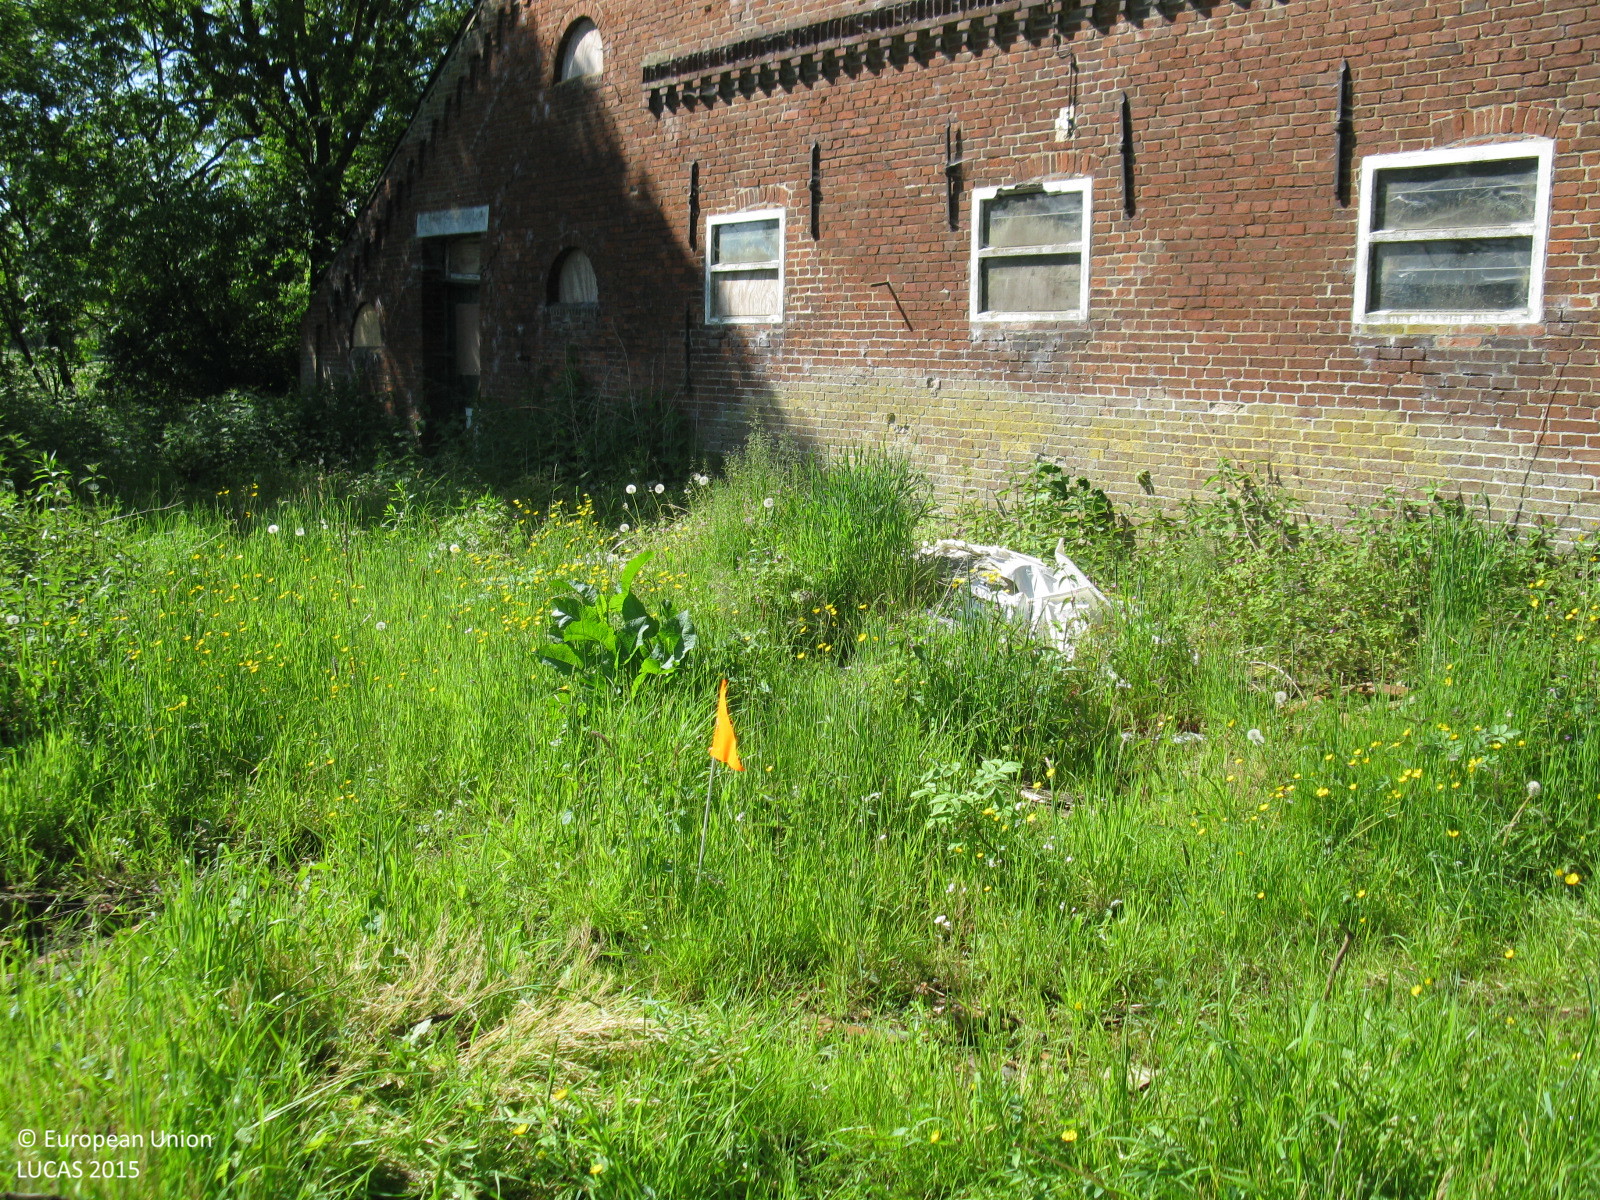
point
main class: Grassland
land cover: Grassland without tree/shrub cover
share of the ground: > 75 %
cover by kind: herbaceous plants 100 %
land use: Residential
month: June
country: DE
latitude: 53.2836
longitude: 7.3757
